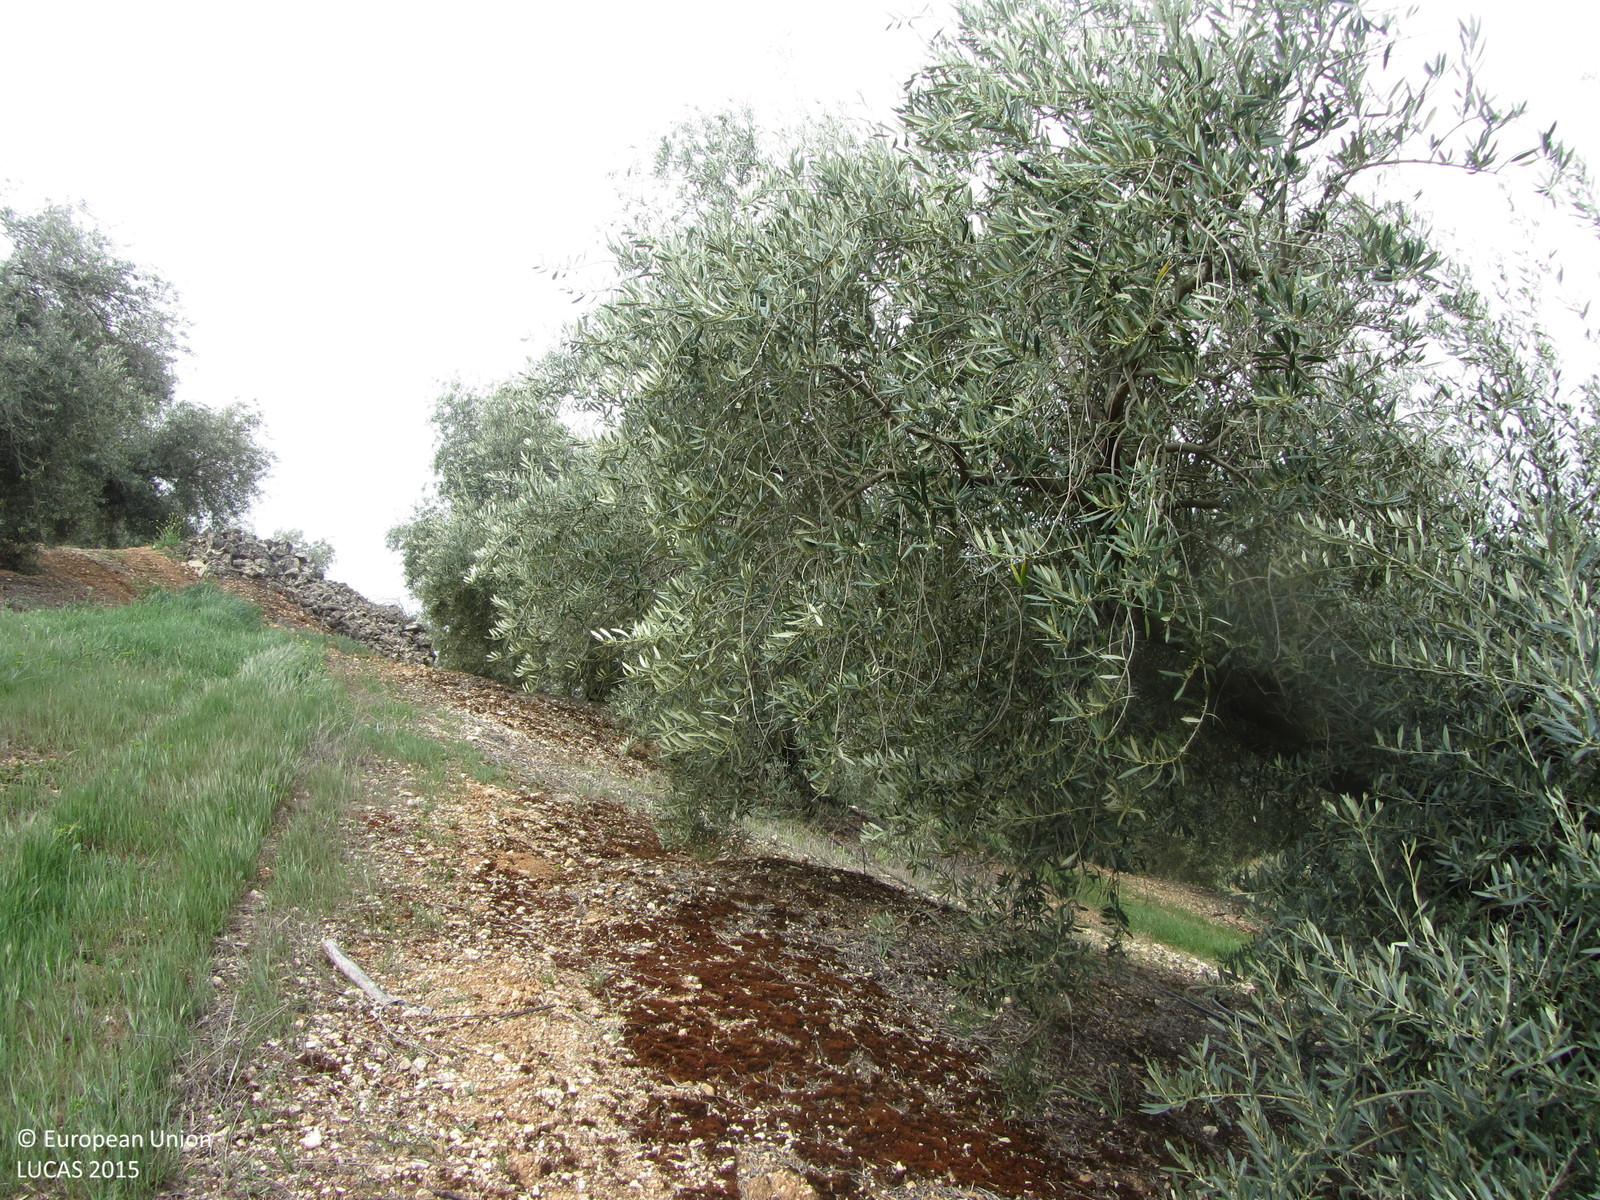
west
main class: Cropland
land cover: Olive groves
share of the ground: 50 - 75 %
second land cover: Spontaneously vegetated surfaces
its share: 10 - 25 %
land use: Agriculture (excluding fallow land and kitchen gardens)
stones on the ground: > 50 %
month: April
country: ES
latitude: 38.0820
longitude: -2.9828
